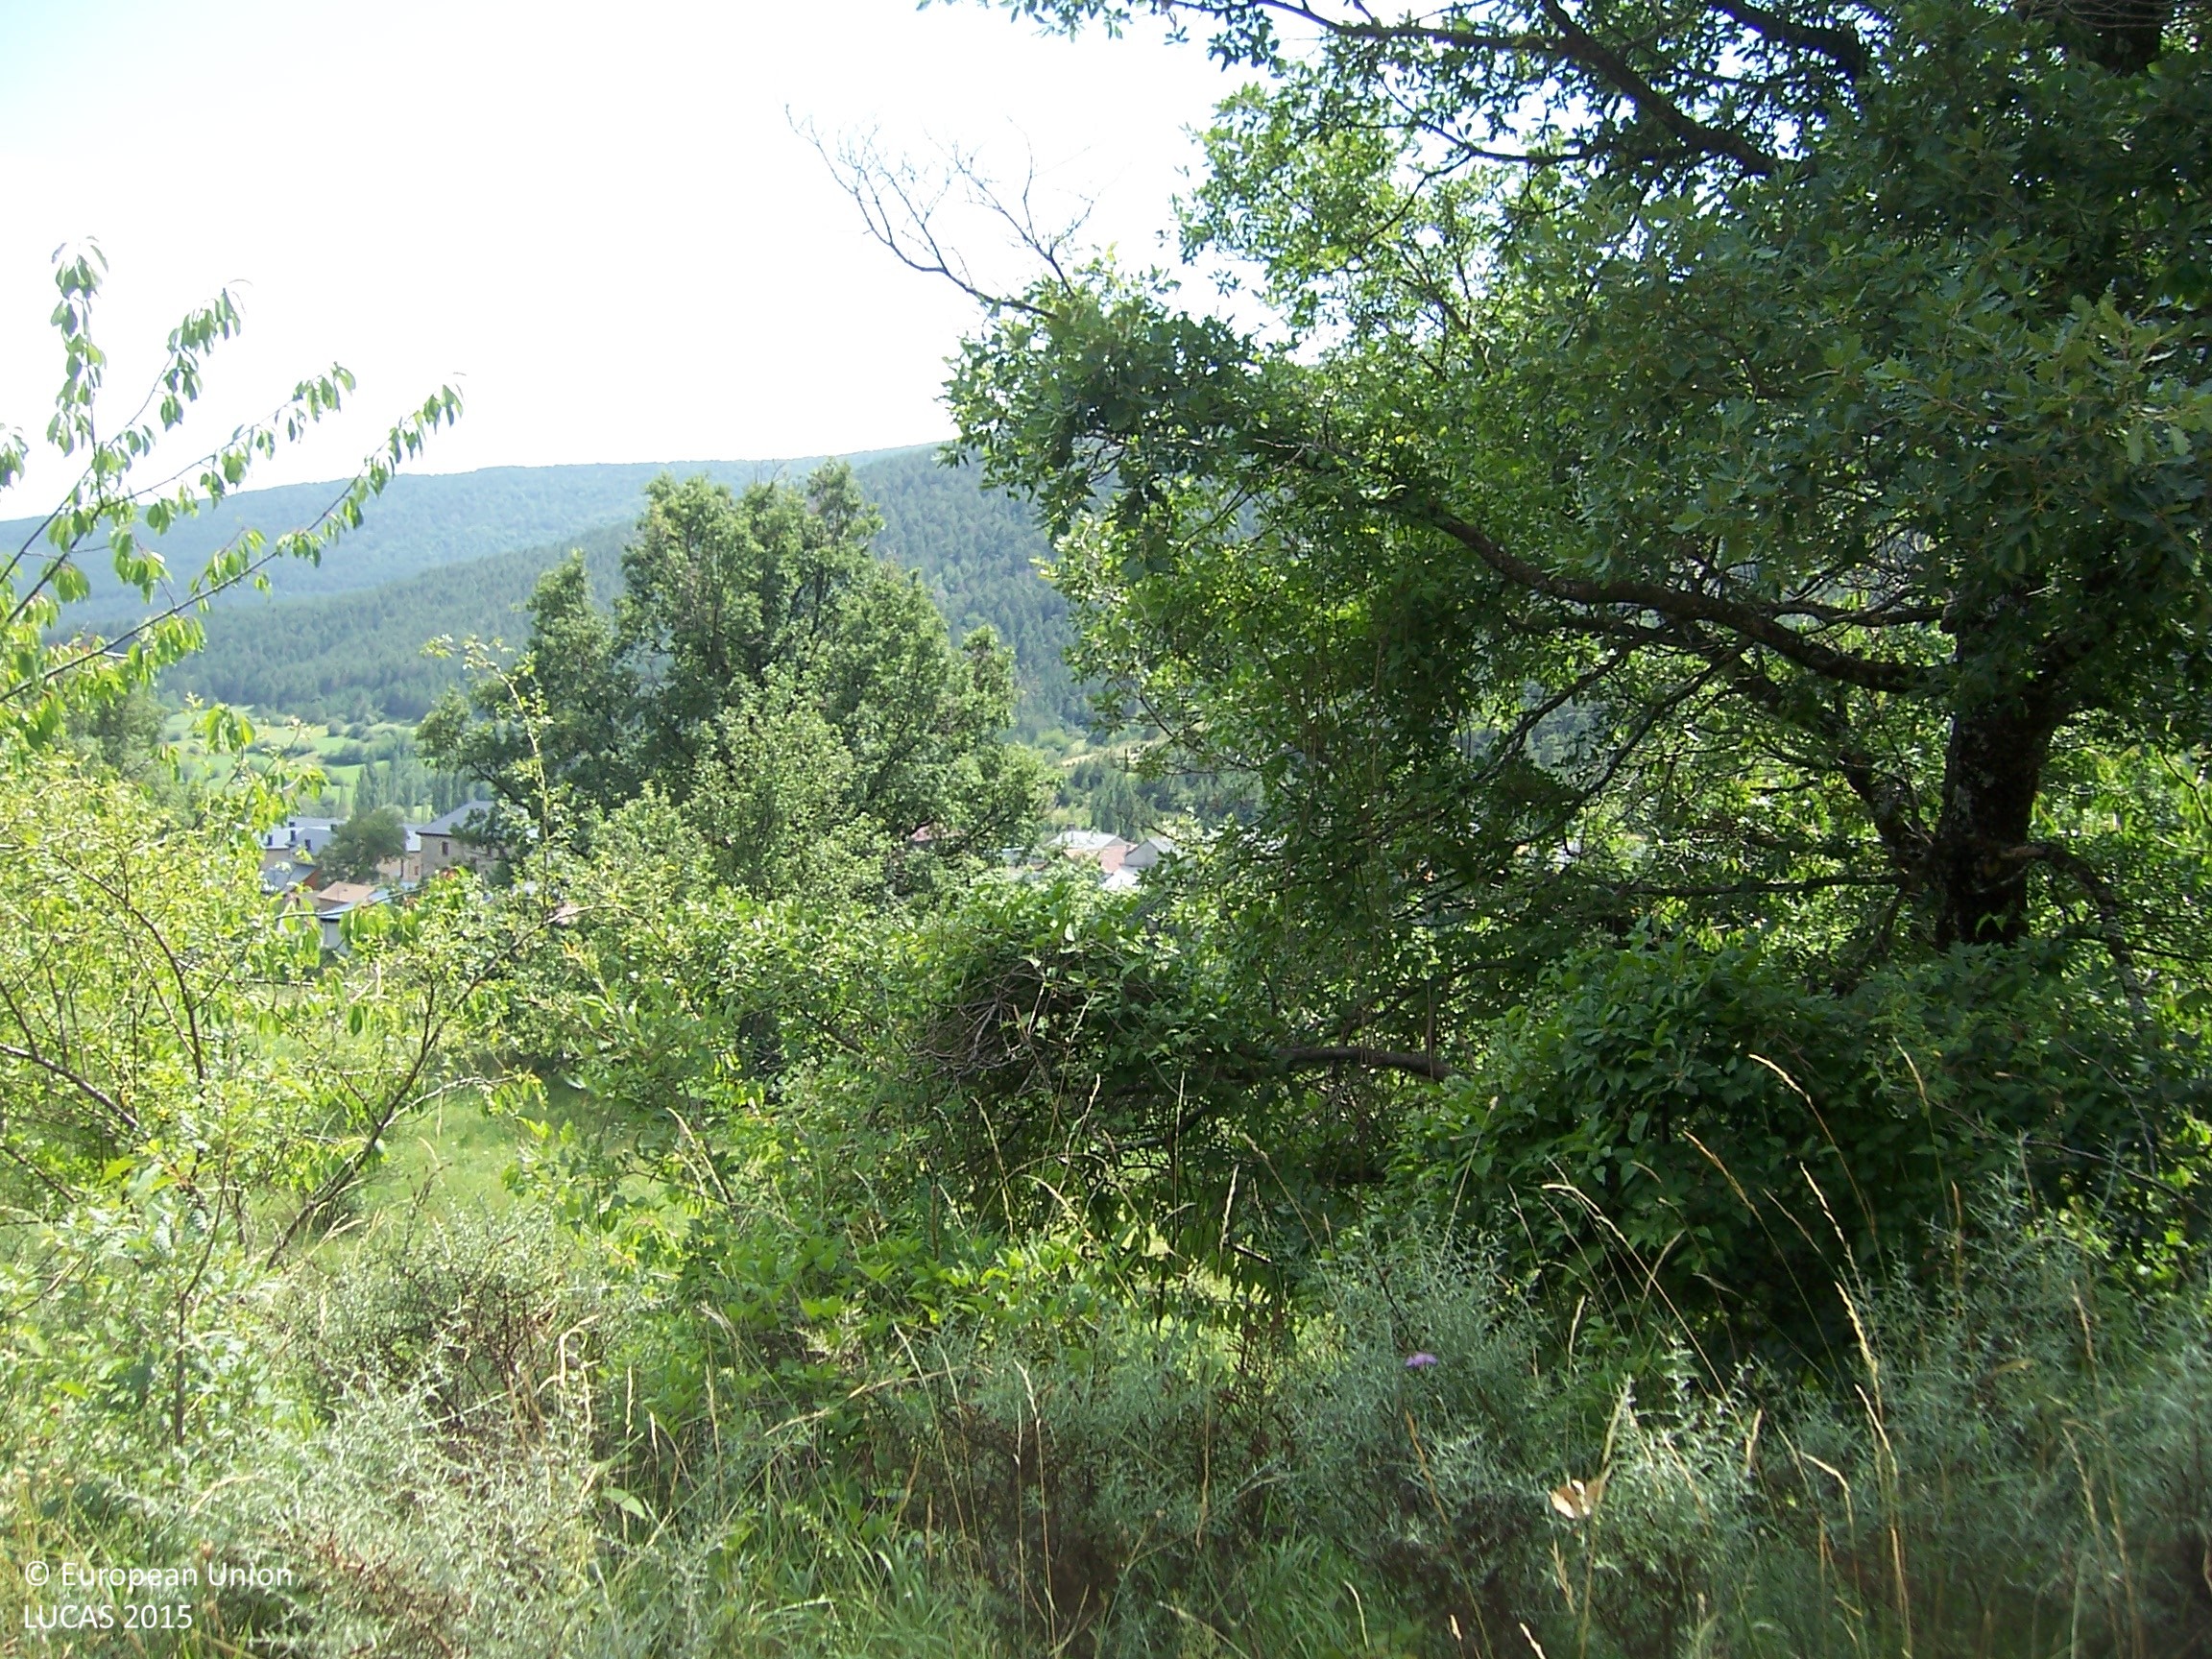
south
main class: Woodland
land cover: Pine dominated coniferous woodland
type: alpine coniferous forest
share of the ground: > 75 %
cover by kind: coniferous forest trees 85 %, shrubs 10 %, unconsolidated bare surface 5 %
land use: Forestry
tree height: > 5 m
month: August
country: ES
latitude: 42.6467
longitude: -0.3818
